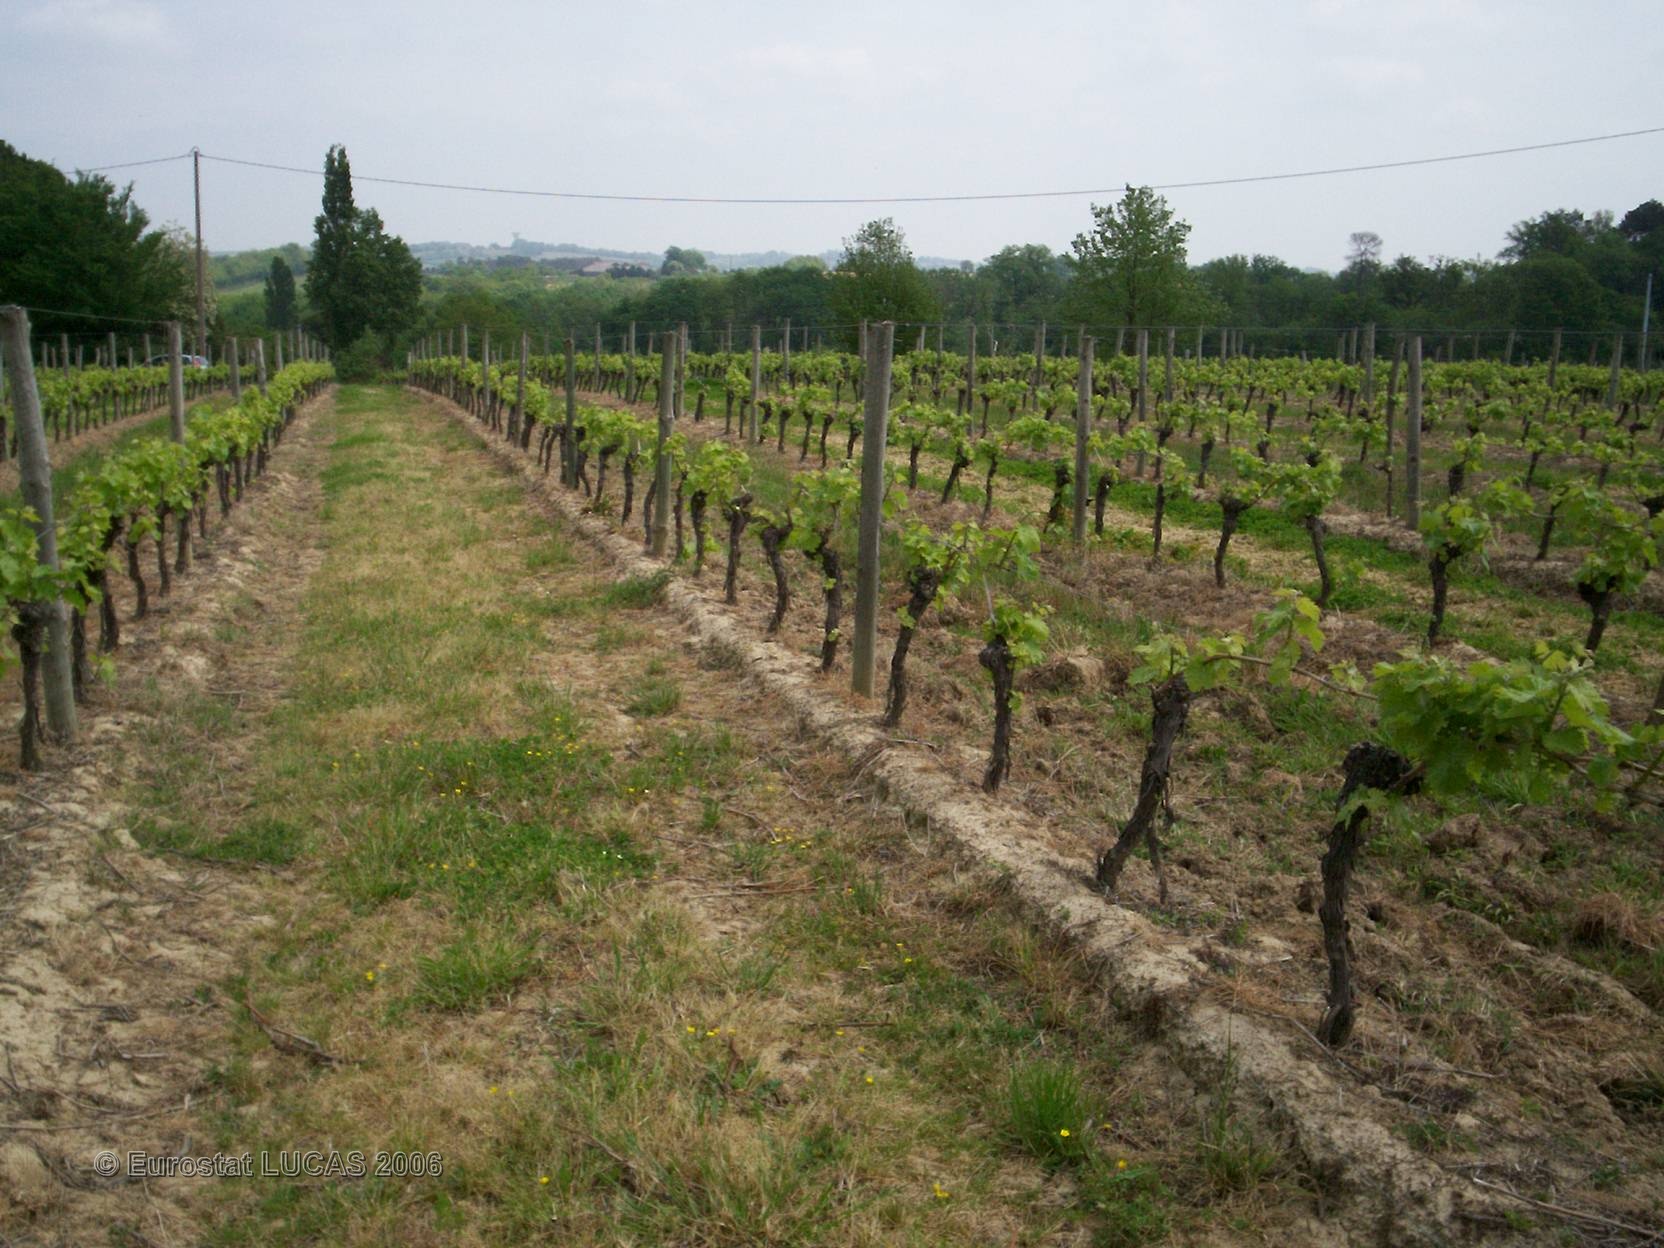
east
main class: Cropland
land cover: Vineyards
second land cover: Grassland with sparse tree/shrub cover
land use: Agriculture (excluding fallow land and kitchen gardens)
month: May
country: FR
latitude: 43.8831
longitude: 0.1732
